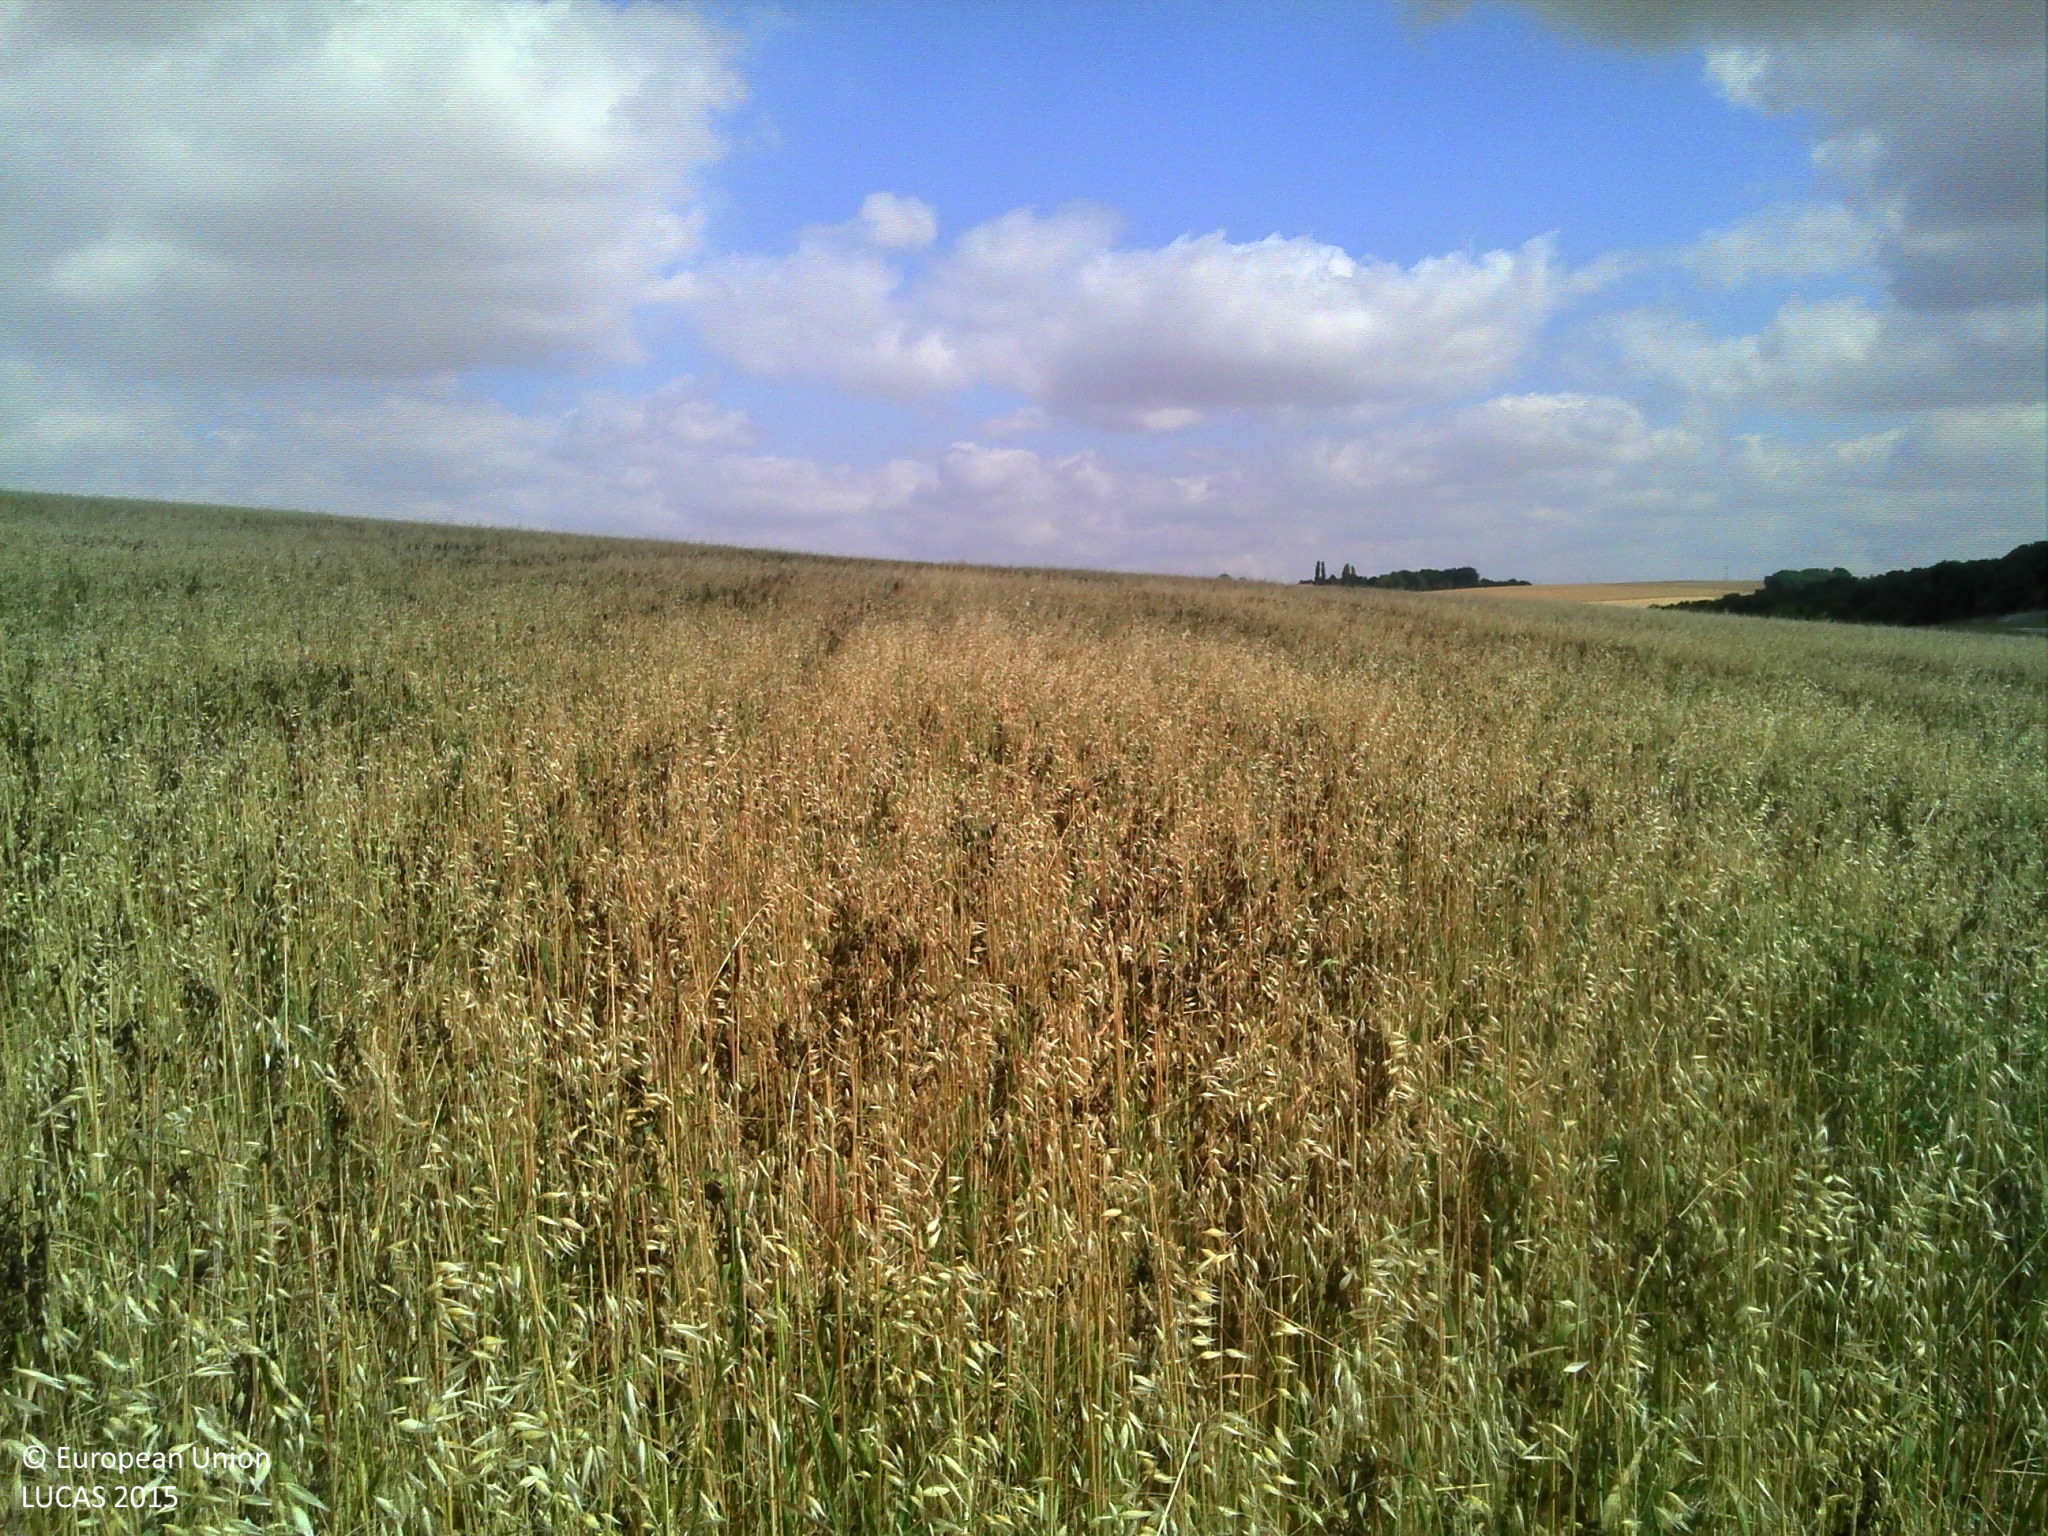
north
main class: Cropland
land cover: Mixed cereals for fodder
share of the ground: > 75 %
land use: Agriculture (excluding fallow land and kitchen gardens)
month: July
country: FR
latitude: 48.3309
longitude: 3.3707
